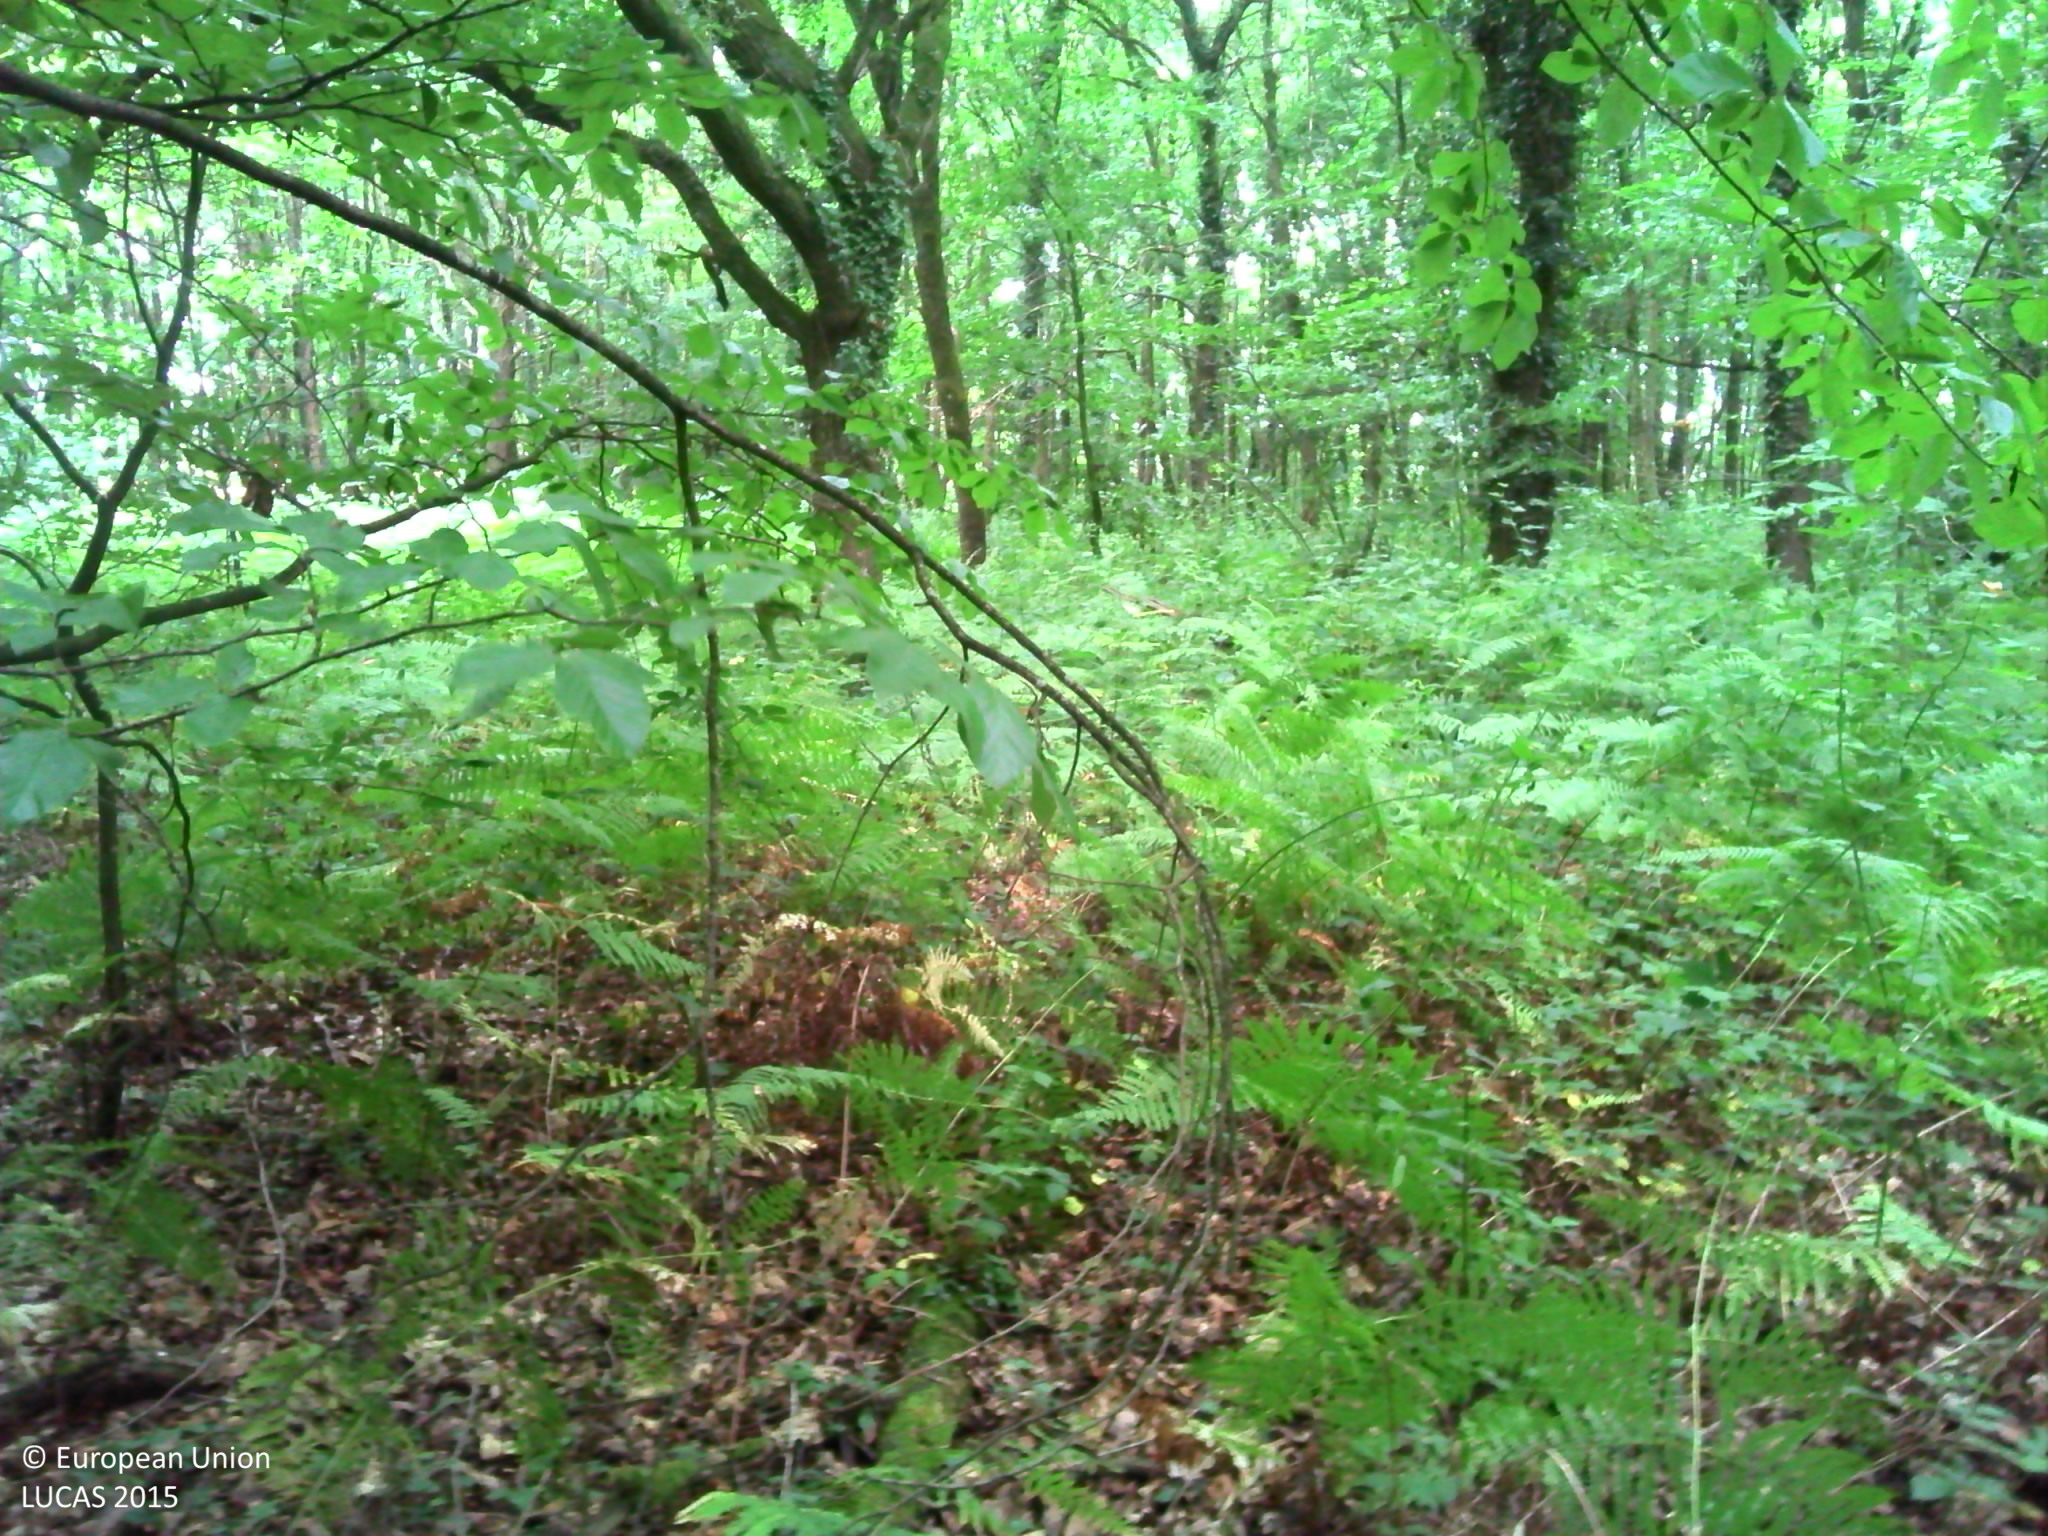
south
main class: Woodland
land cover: Broadleaved woodland
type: mesophytic deciduous forest
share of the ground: > 75 %
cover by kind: broadleaved forest trees 80 %, herbaceous plants 15 %, lichens and mosses 5 %
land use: Forestry
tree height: > 5 m
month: July
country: FR
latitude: 47.8520
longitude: -2.0399
